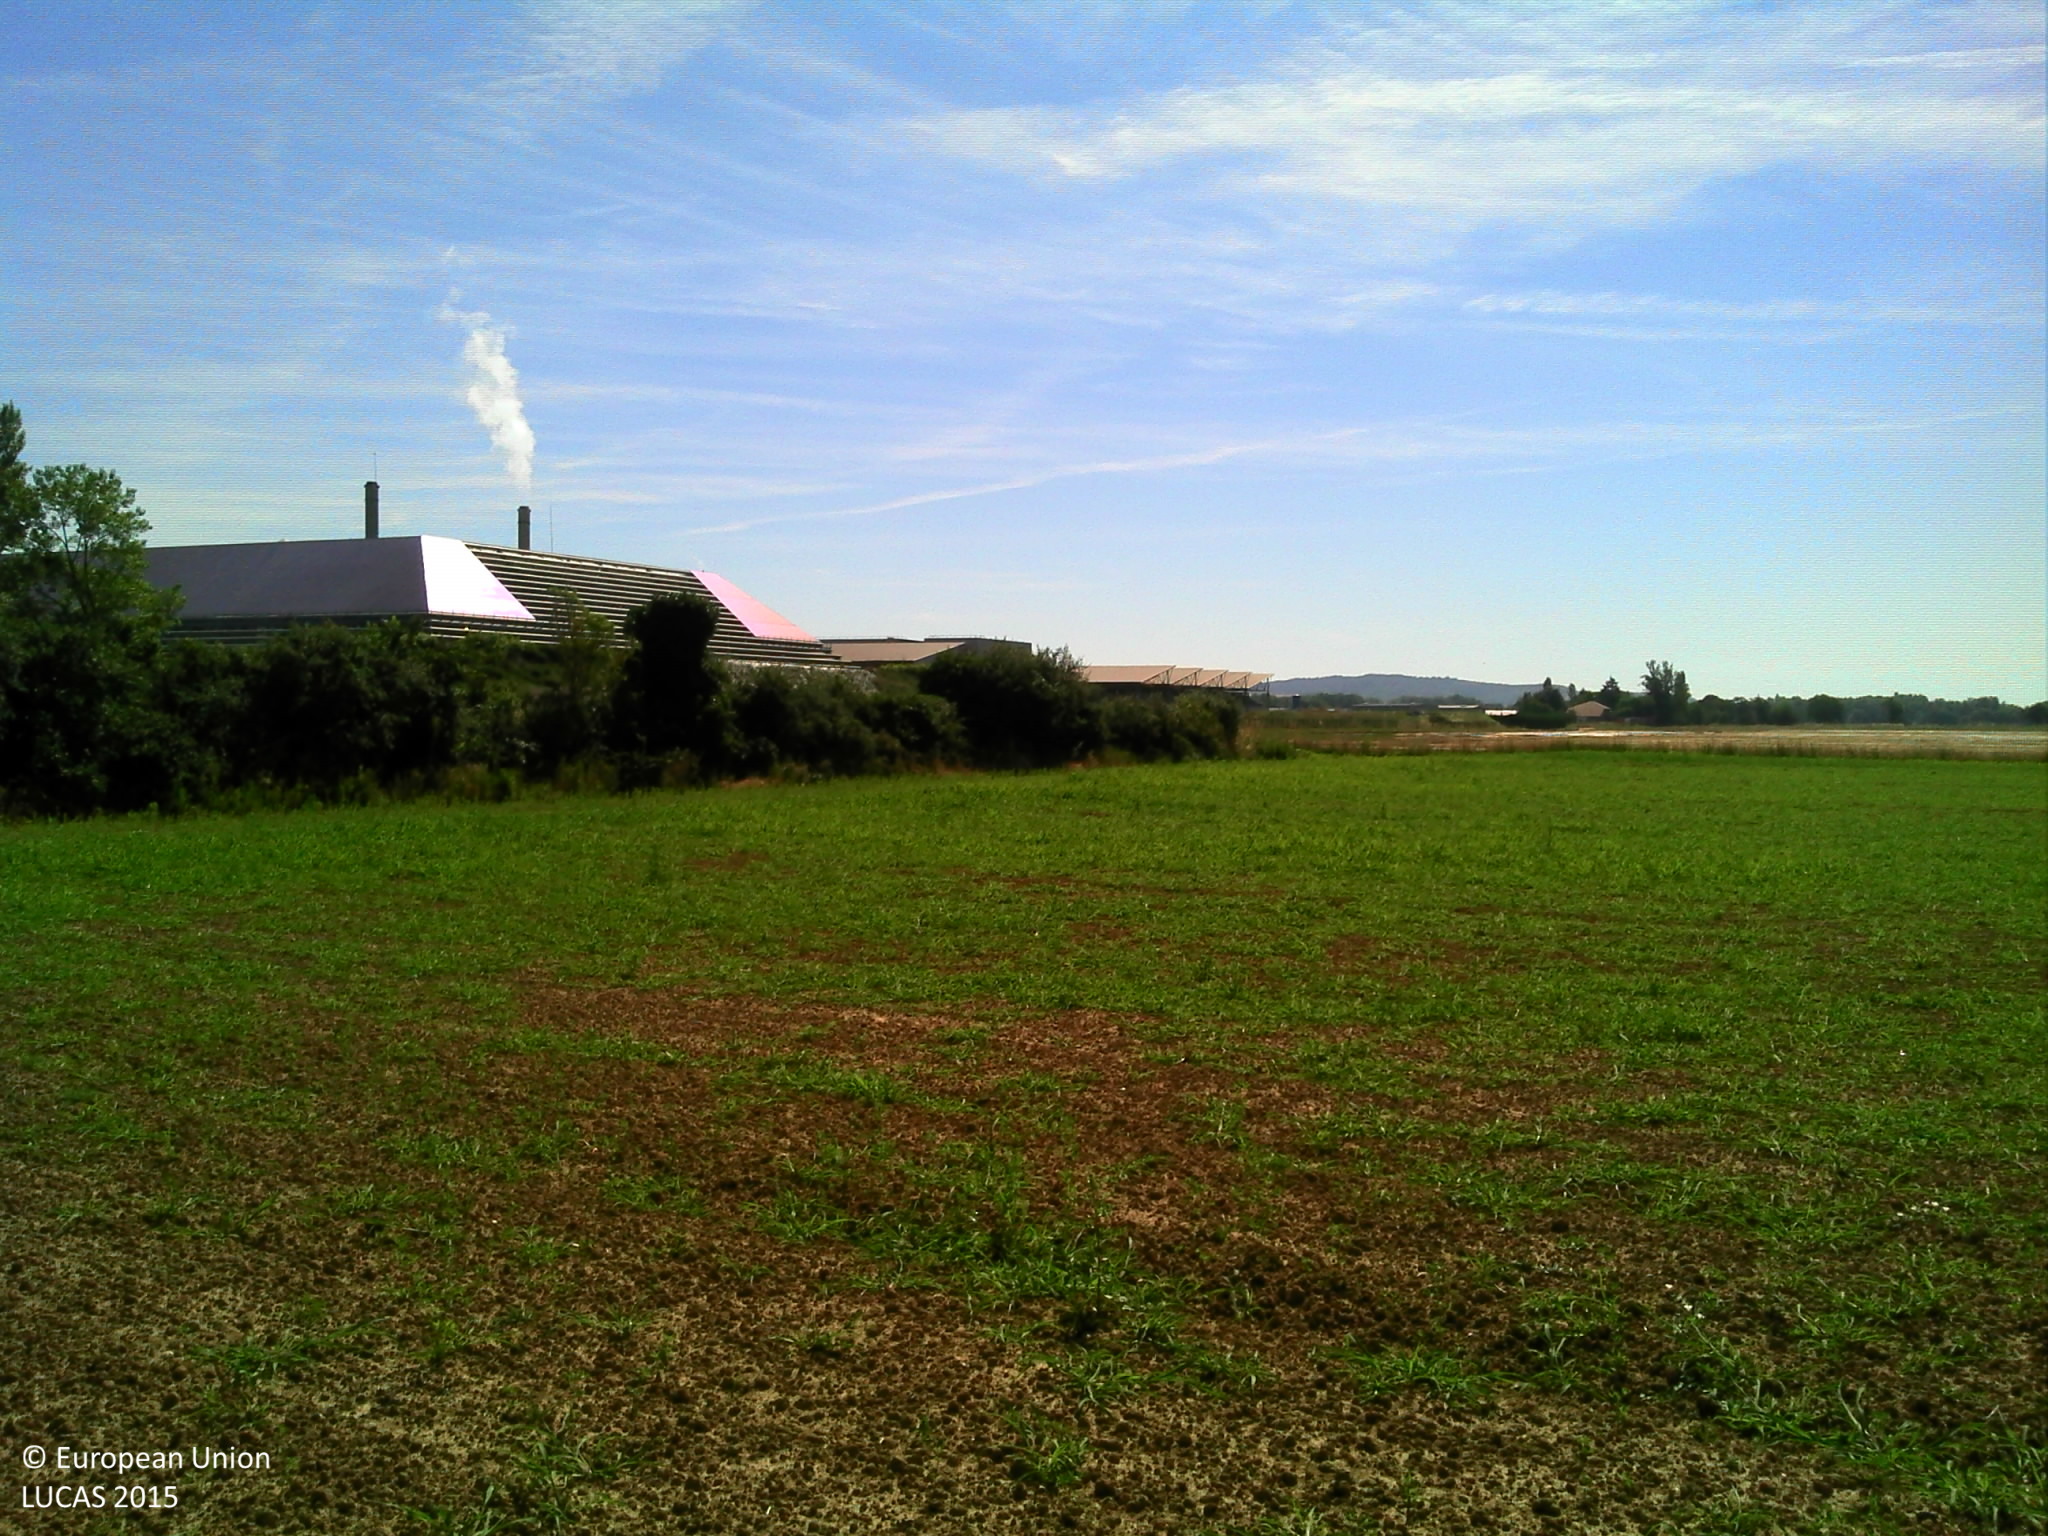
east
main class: Cropland
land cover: Temporary grasslands
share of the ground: 50 - 75 %
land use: Agriculture (excluding fallow land and kitchen gardens)
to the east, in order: Temporary grasslands; Managed hedges; Grassland without tree/shrub cover; Grass margins; Paved roads, cycling and walking lanes; Grass margins; Other bare soil; Grassland without tree/shrub cover; Rivers and streams; Grass margins; Fences; Grassland without tree/shrub cover
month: June
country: FR
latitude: 43.8070
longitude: 1.5616
